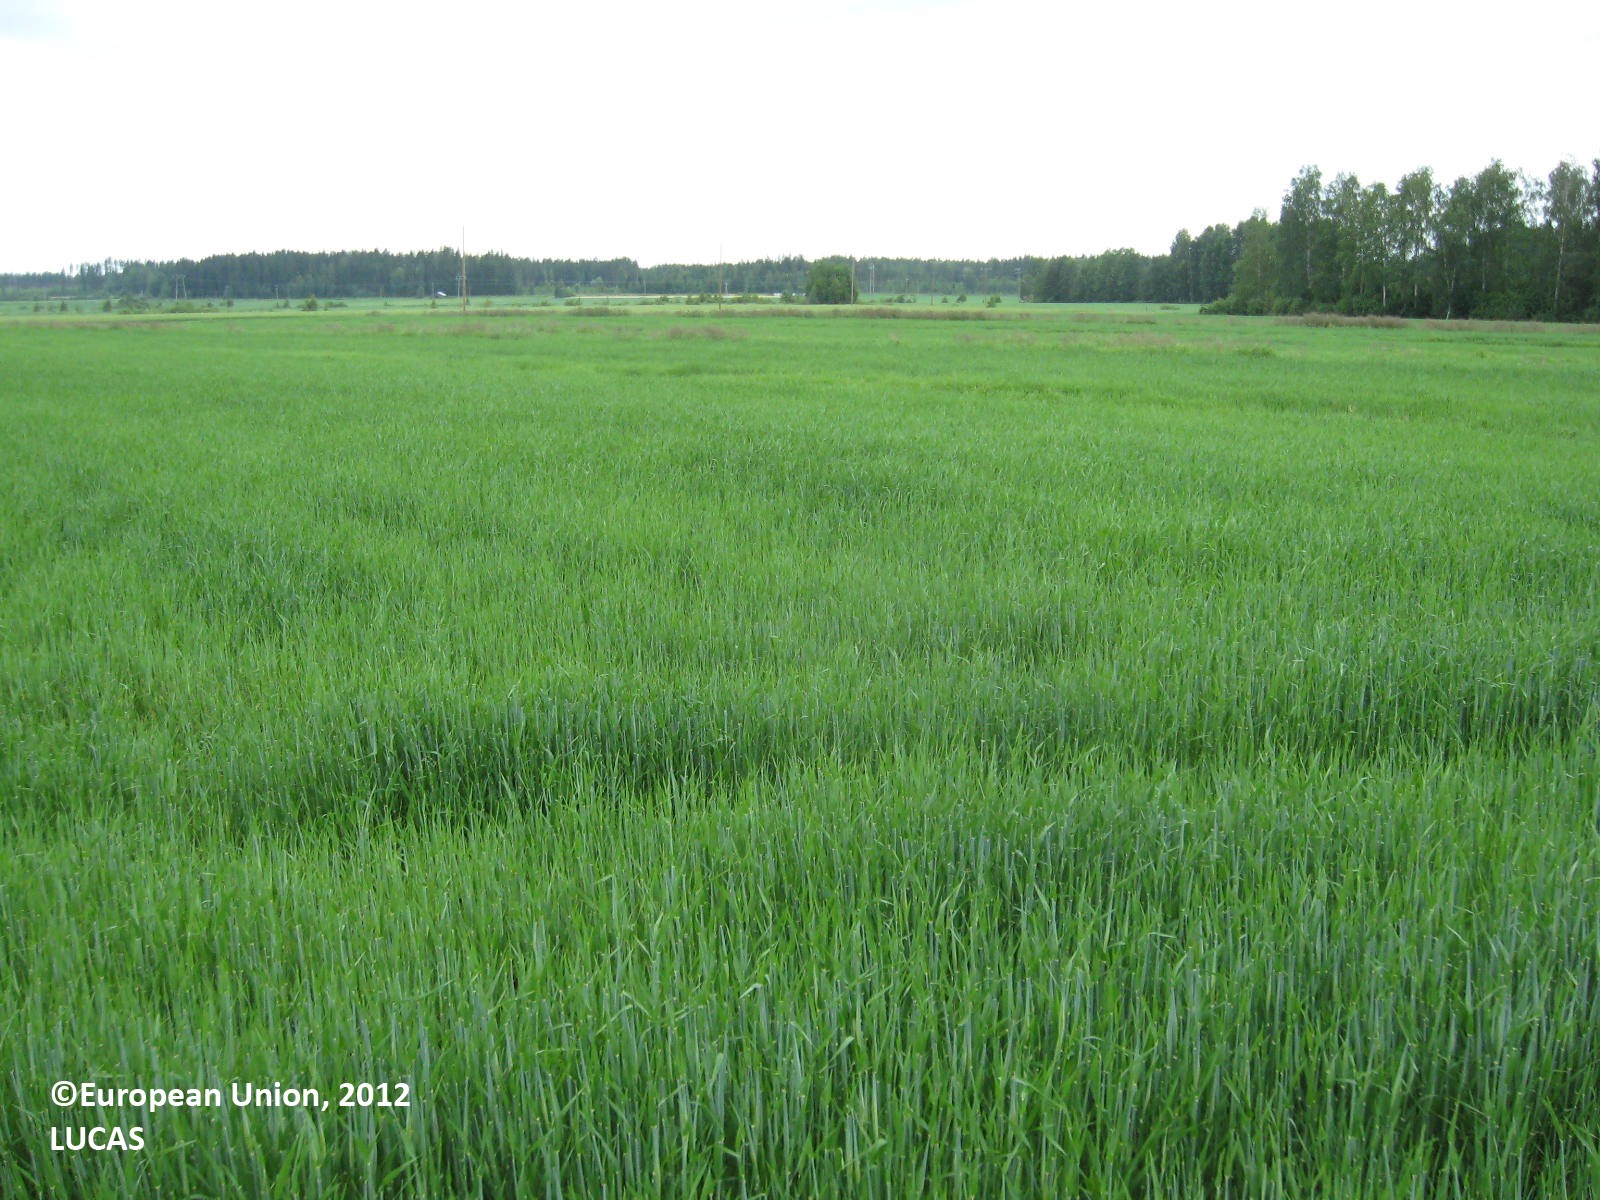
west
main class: Cropland
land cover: Barley
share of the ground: > 75 %
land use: Agriculture (excluding fallow land and kitchen gardens)
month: July
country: FI
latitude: 62.5126
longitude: 22.8985
